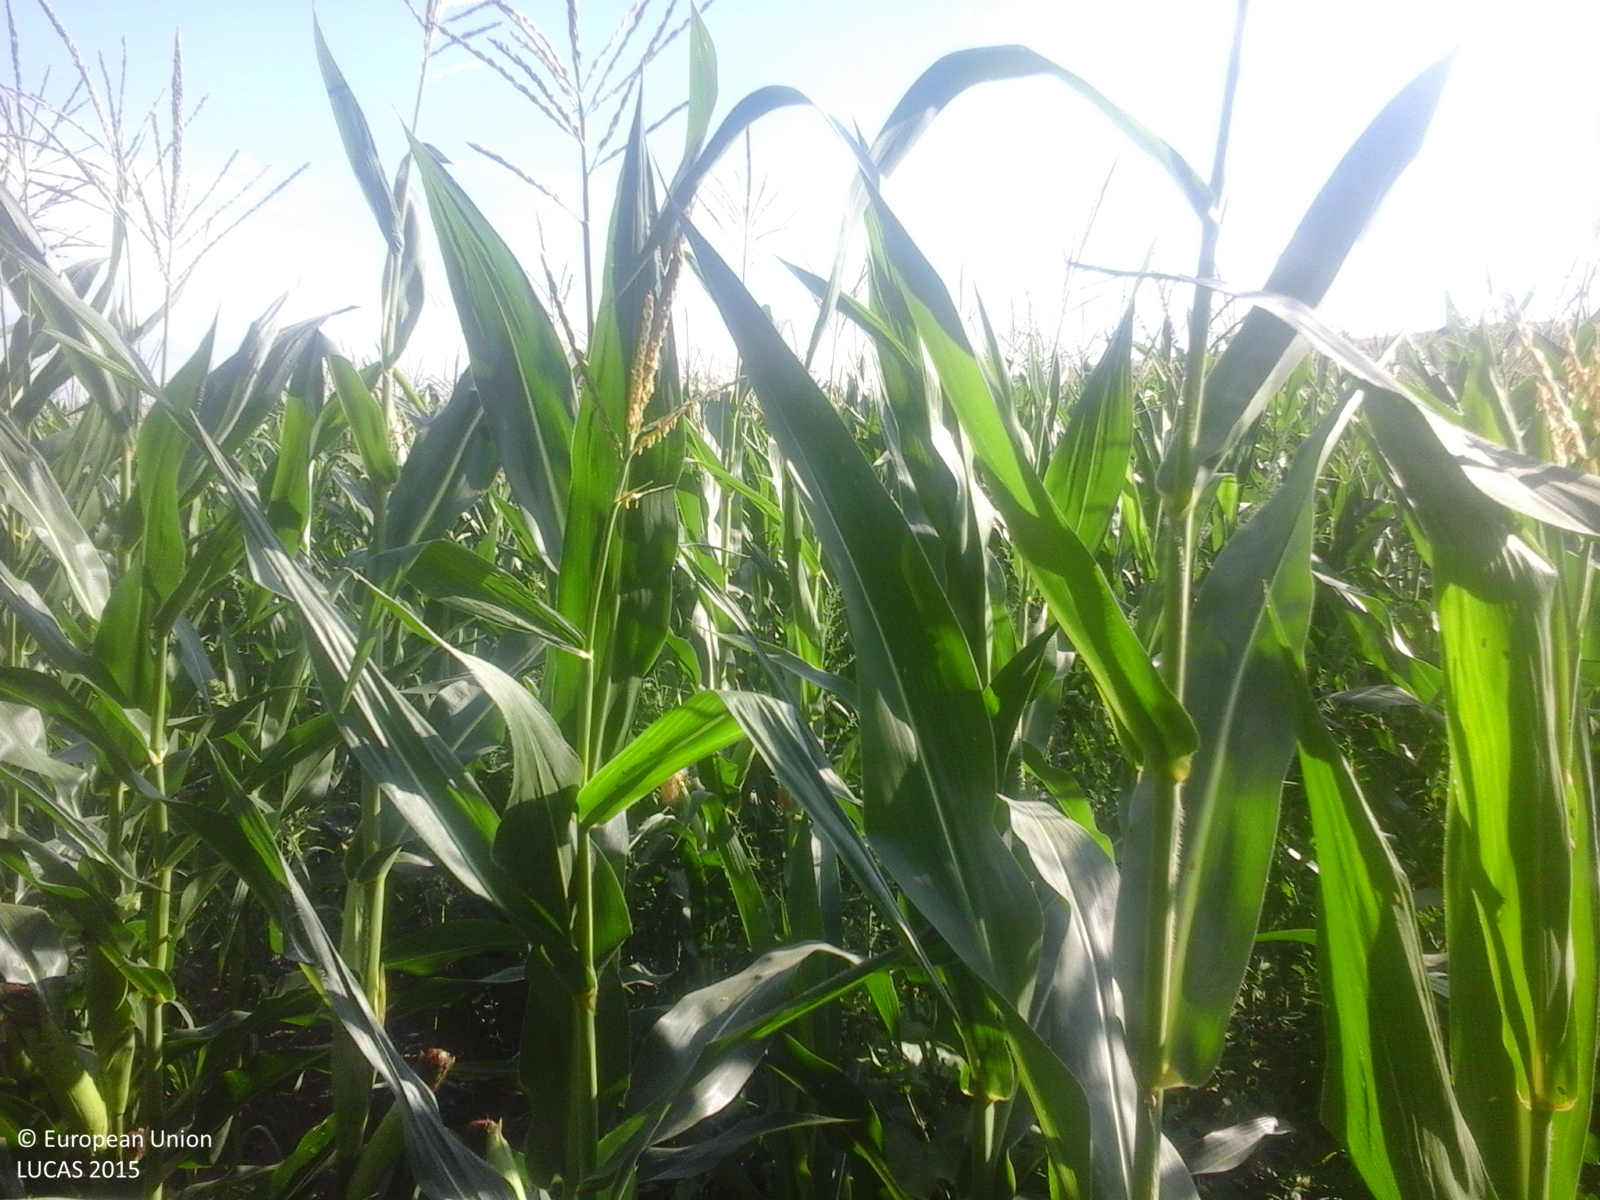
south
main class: Cropland
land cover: Maize
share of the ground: > 75 %
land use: Agriculture (excluding fallow land and kitchen gardens)
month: July
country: RO
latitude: 46.4356
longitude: 27.9683
